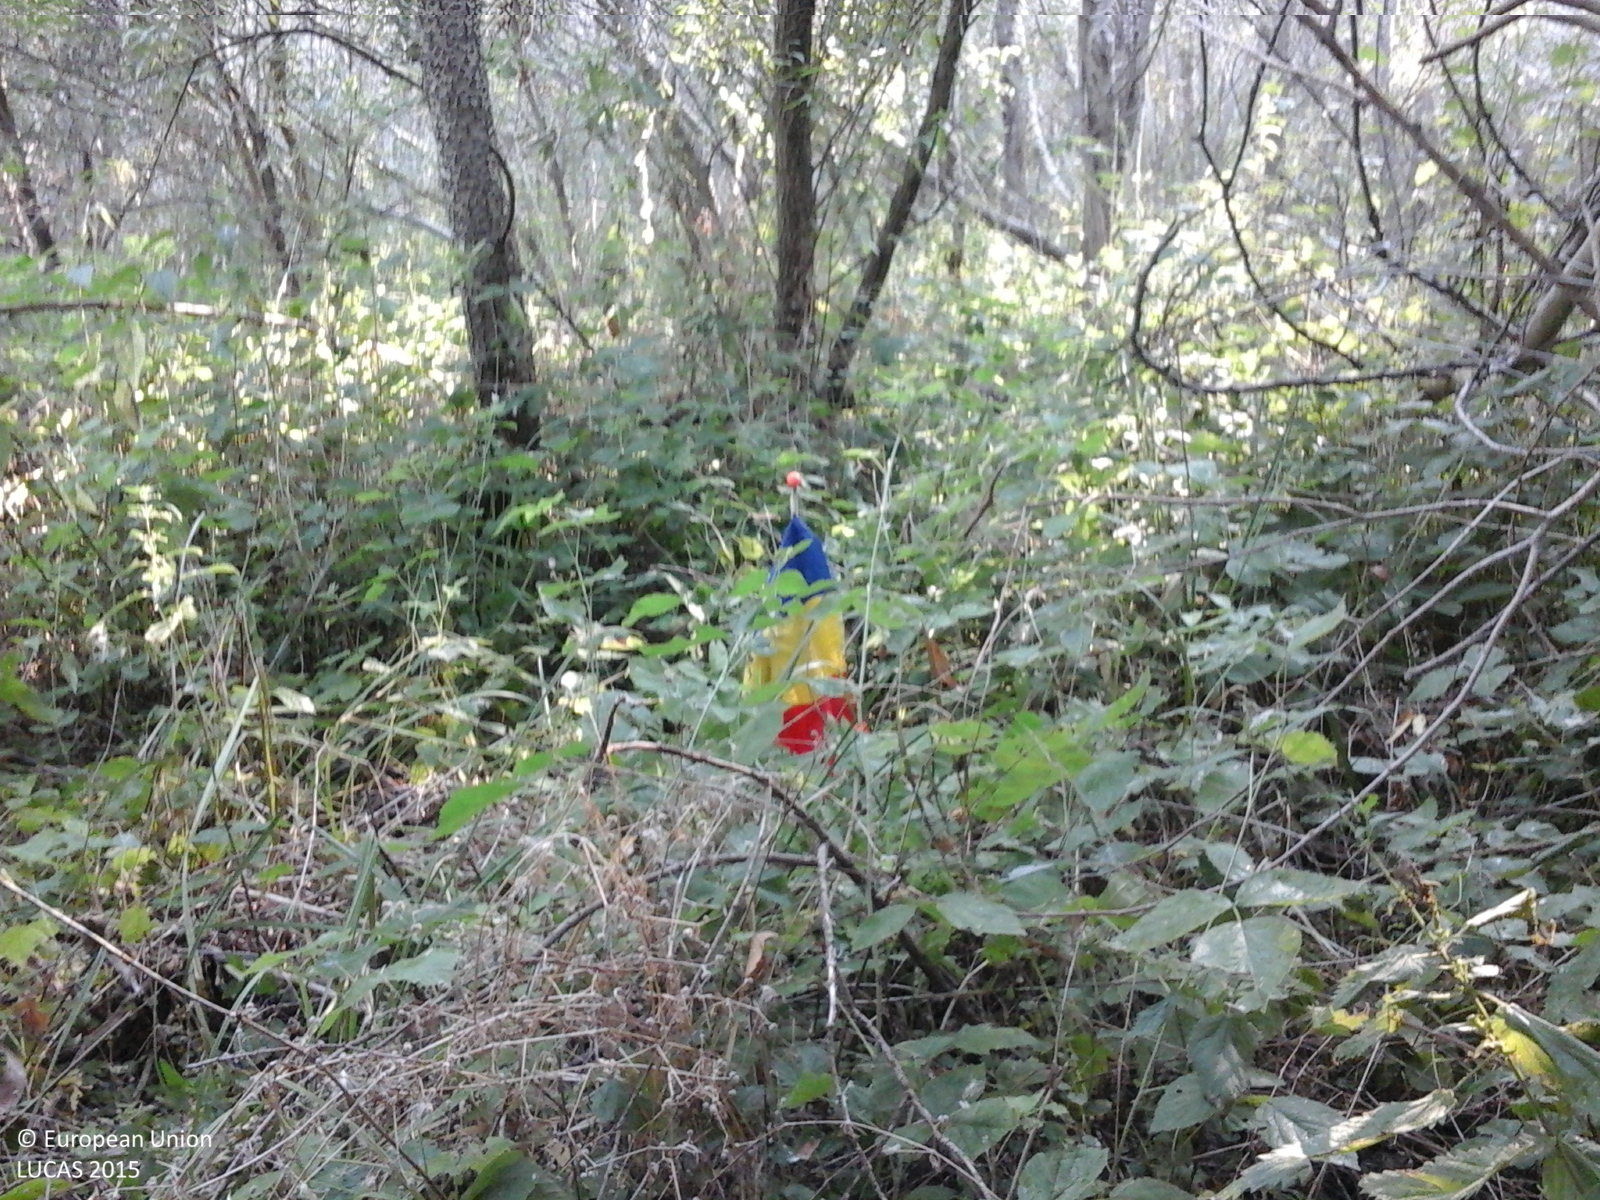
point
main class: Woodland
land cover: Broadleaved woodland
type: floodplain forest
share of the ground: > 75 %
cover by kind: broadleaved forest trees 100 %
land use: Forestry
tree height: > 5 m
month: July
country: RO
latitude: 46.3051
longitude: 28.1917
